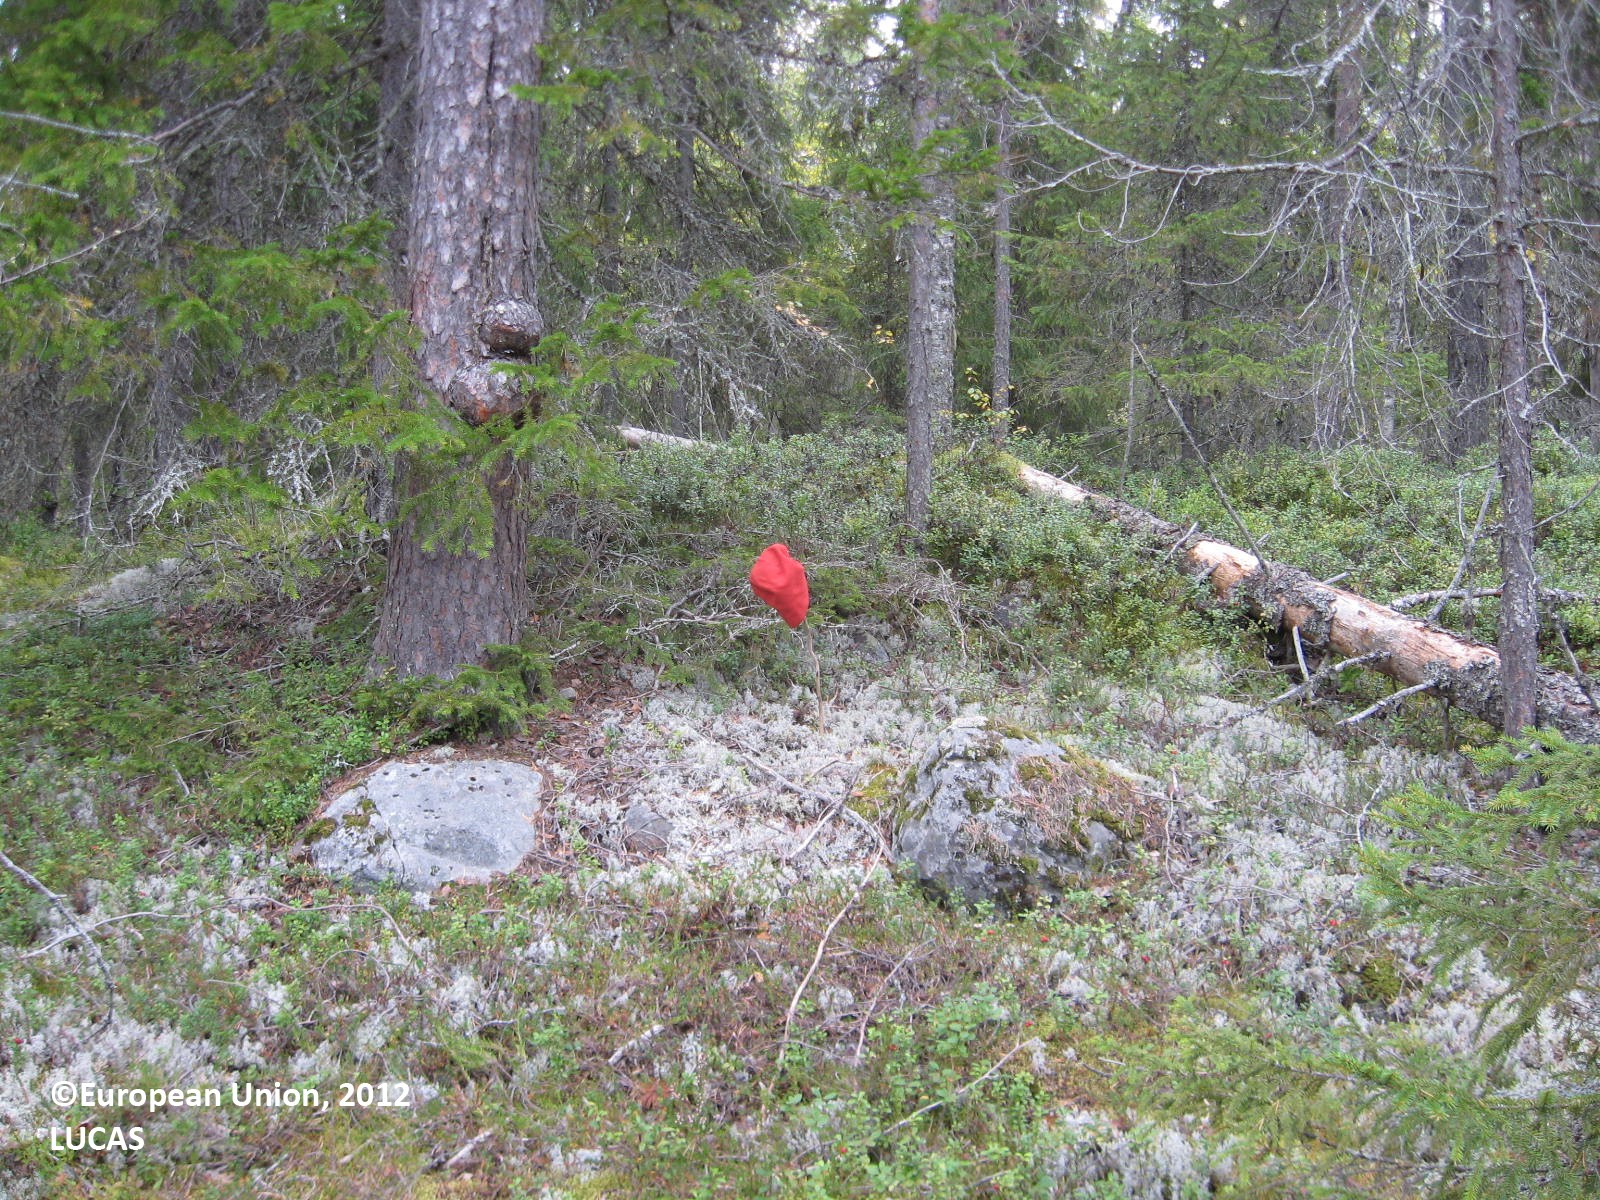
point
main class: Woodland
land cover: Pine dominated coniferous woodland
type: boreal forest
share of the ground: > 75 %
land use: Forestry
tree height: > 5 m
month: August
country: FI
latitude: 63.9534
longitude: 29.5108
